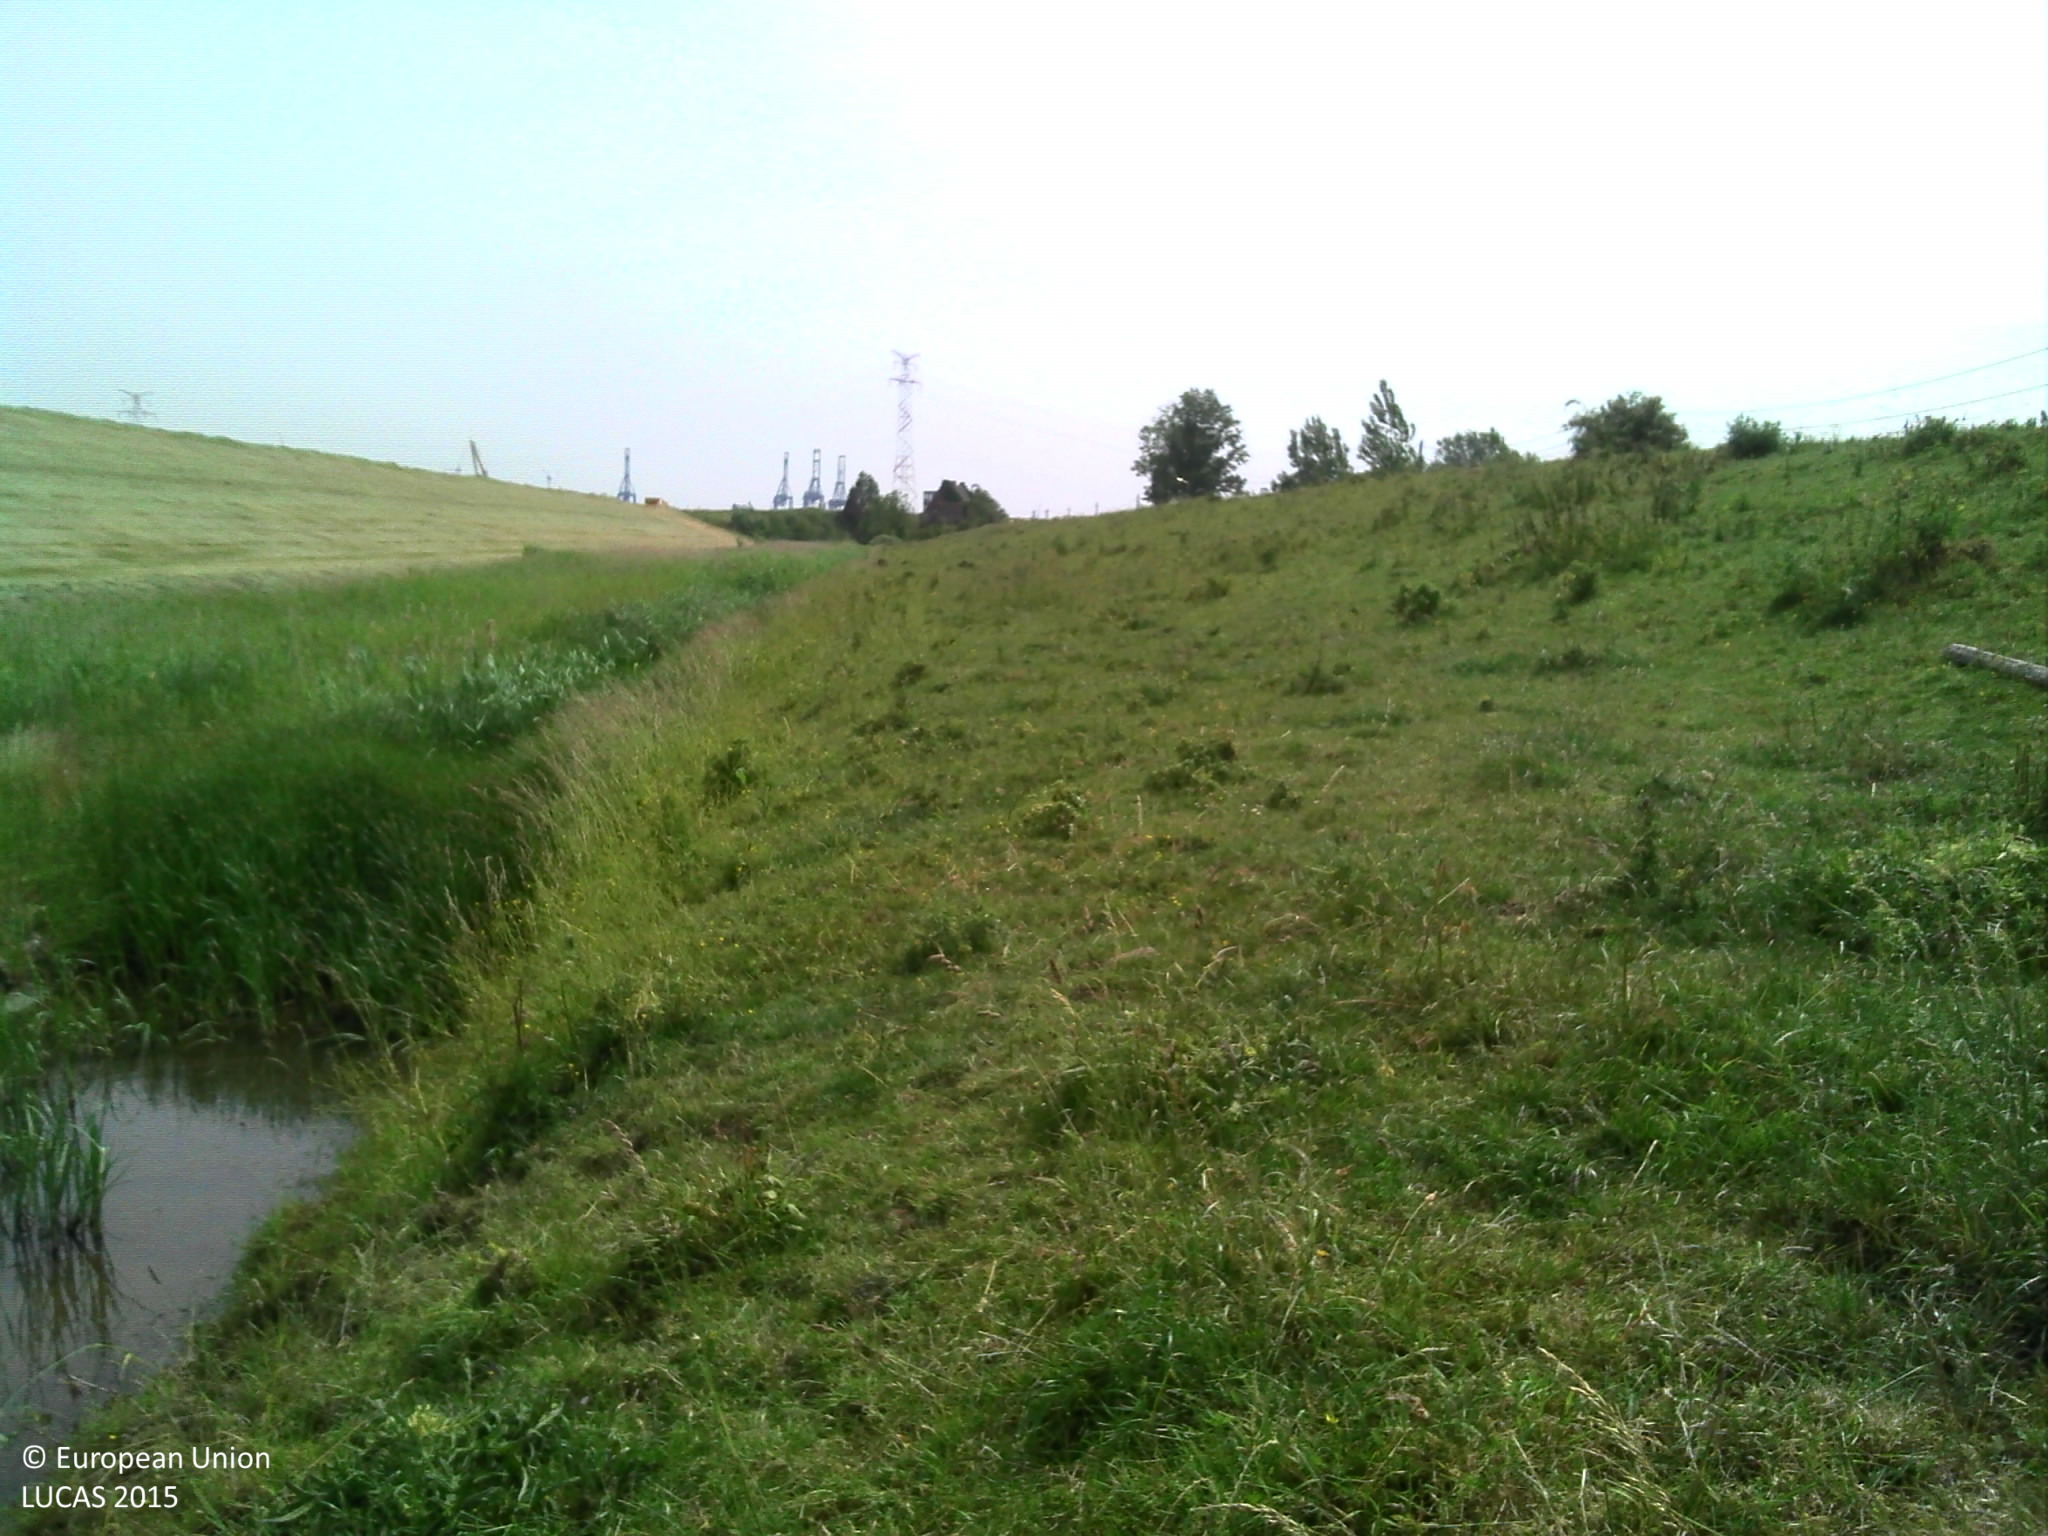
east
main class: Grassland
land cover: Spontaneously vegetated surfaces
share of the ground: > 75 %
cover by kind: herbaceous plants 100 %
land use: Semi-natural and natural areas not in use
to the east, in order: Spontaneously vegetated surfaces; Inland fresh running water; Grassland without tree/shrub cover
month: June
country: BE
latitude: 51.3365
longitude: 4.2390
